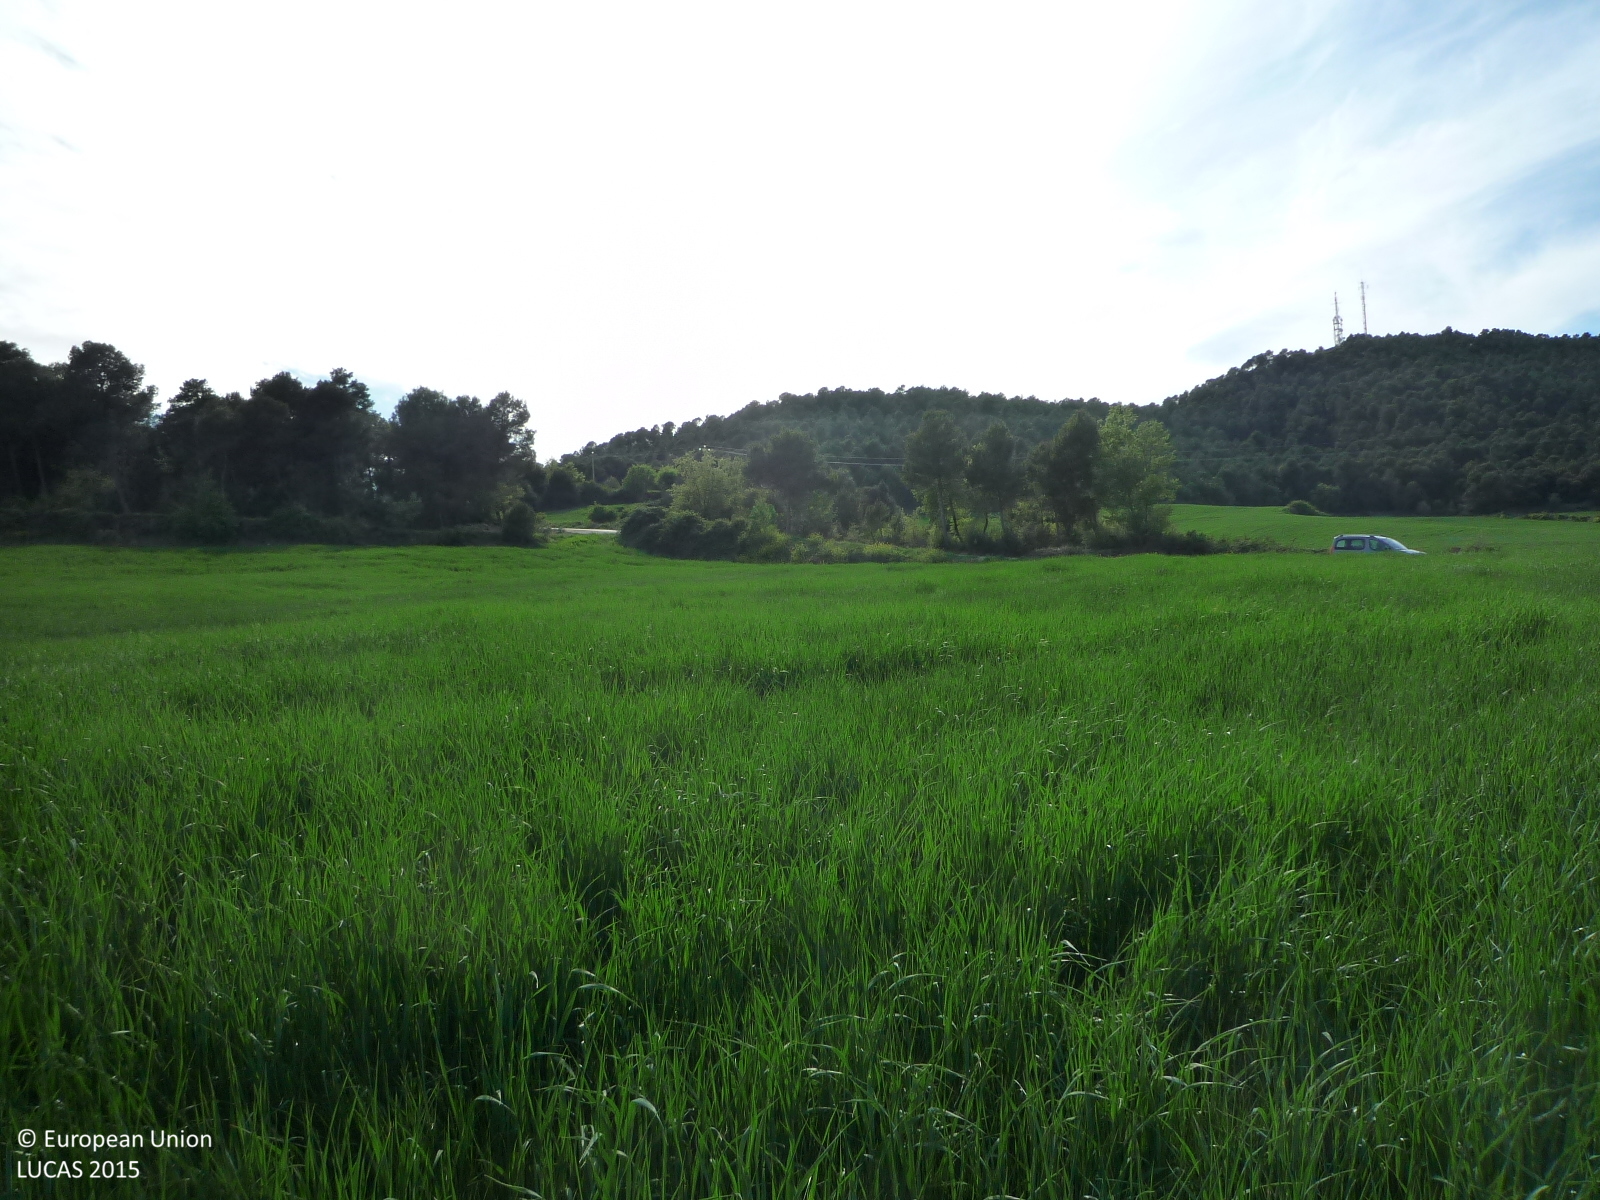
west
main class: Cropland
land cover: Oats
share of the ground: > 75 %
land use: Agriculture (excluding fallow land and kitchen gardens)
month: April
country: ES
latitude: 41.7467
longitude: 1.6571
